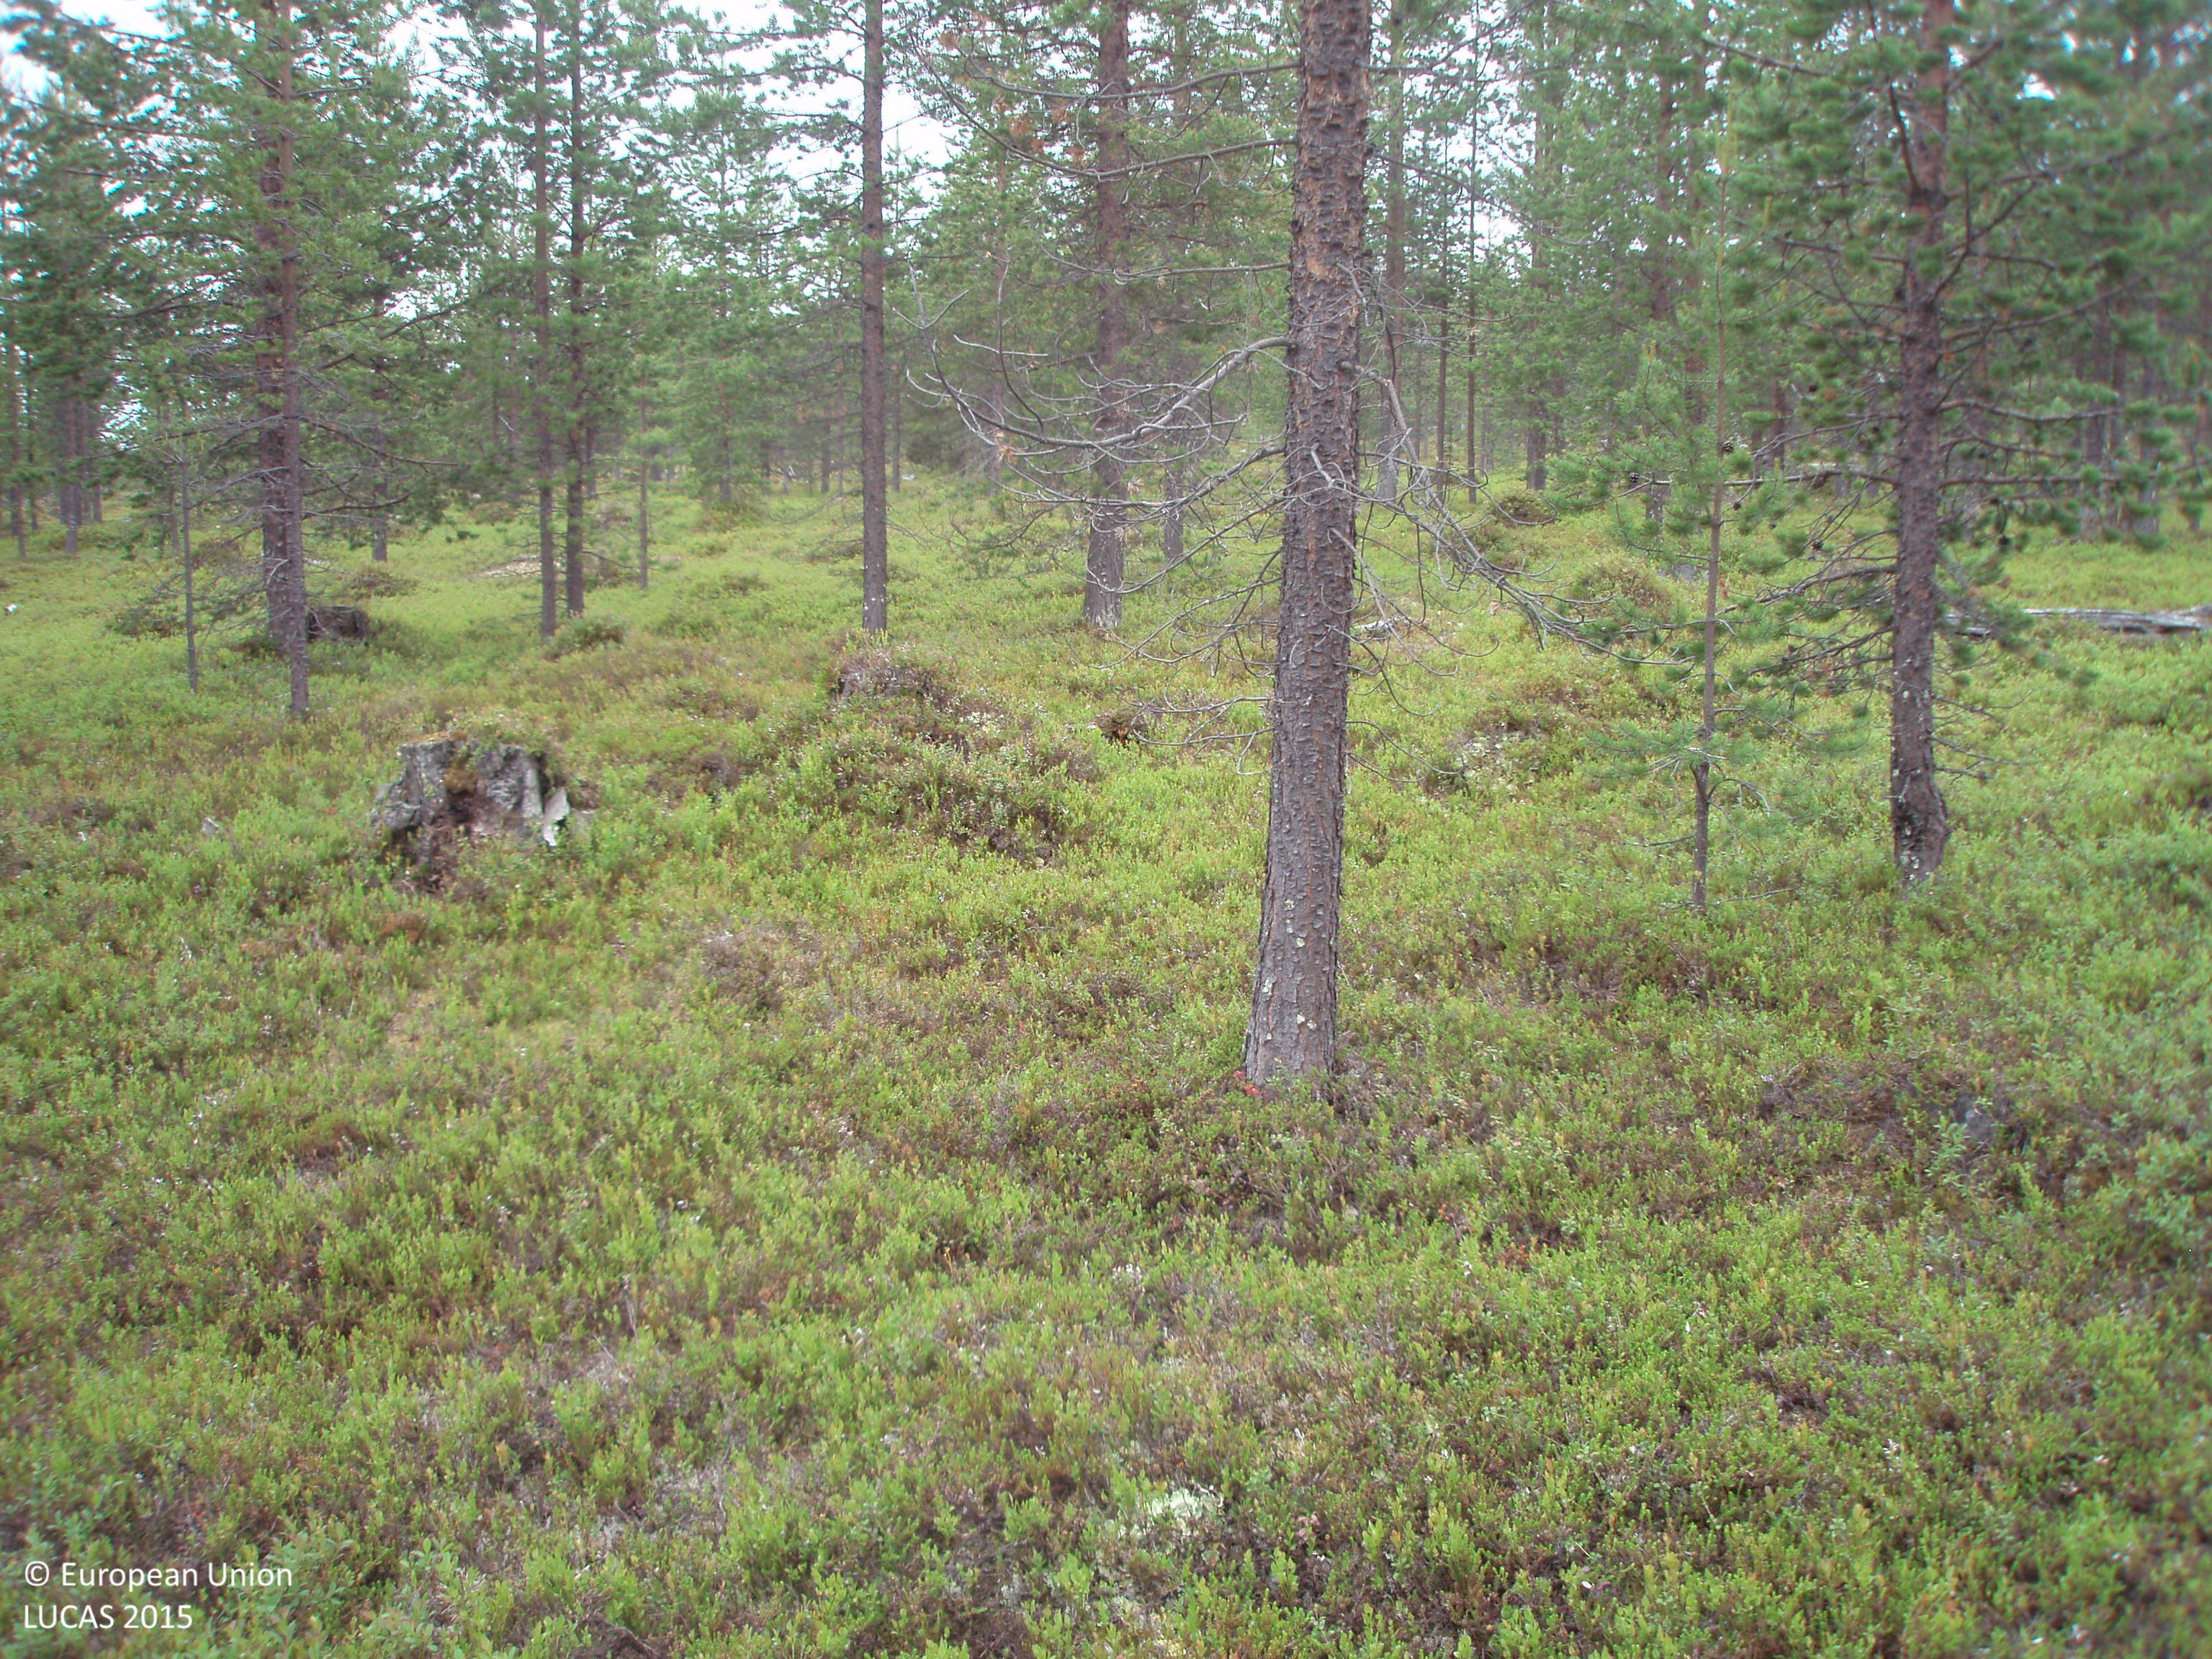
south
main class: Woodland
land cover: Pine dominated coniferous woodland
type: boreal forest
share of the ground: 50 - 75 %
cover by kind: coniferous forest trees 50 %, shrubs 50 %
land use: Forestry
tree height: > 5 m
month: July
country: FI
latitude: 67.7229
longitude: 28.9316
